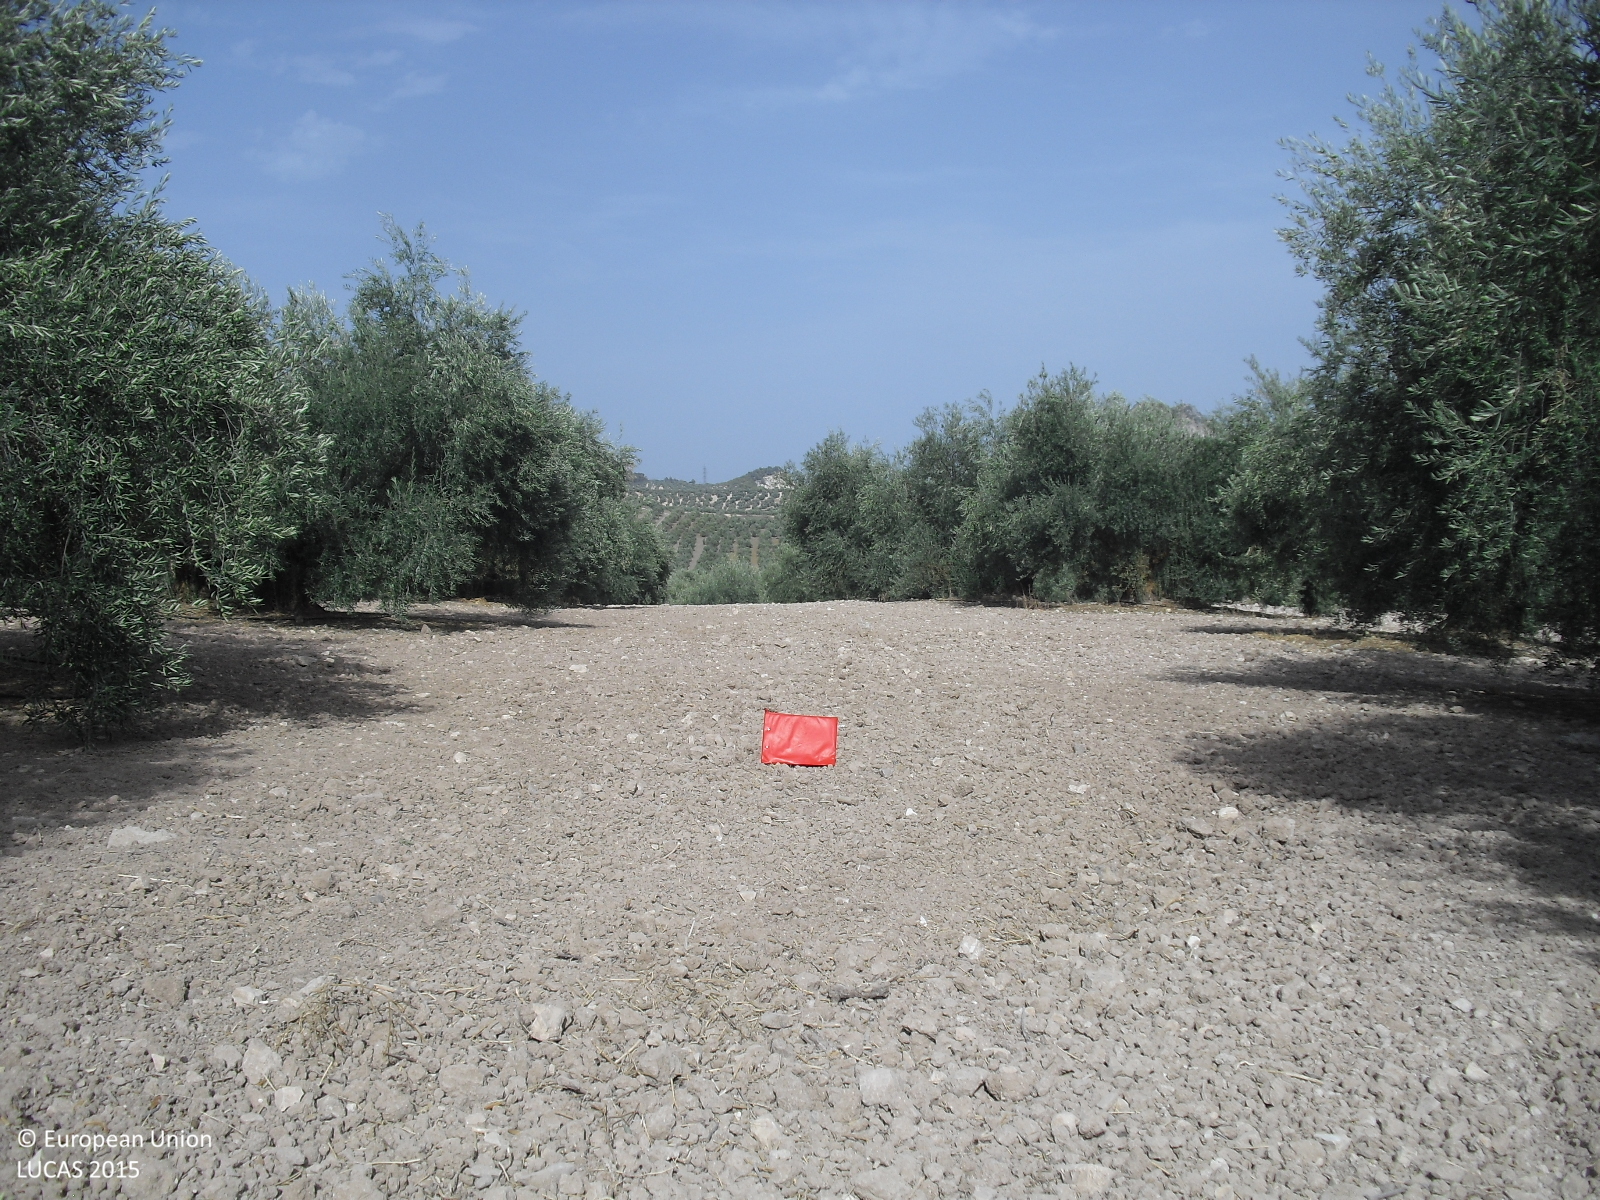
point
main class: Cropland
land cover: Olive groves
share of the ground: 25 - 50 %
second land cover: Other bare soil
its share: > 75 %
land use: Agriculture (excluding fallow land and kitchen gardens)
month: August
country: ES
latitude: 37.2849
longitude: -4.4259
